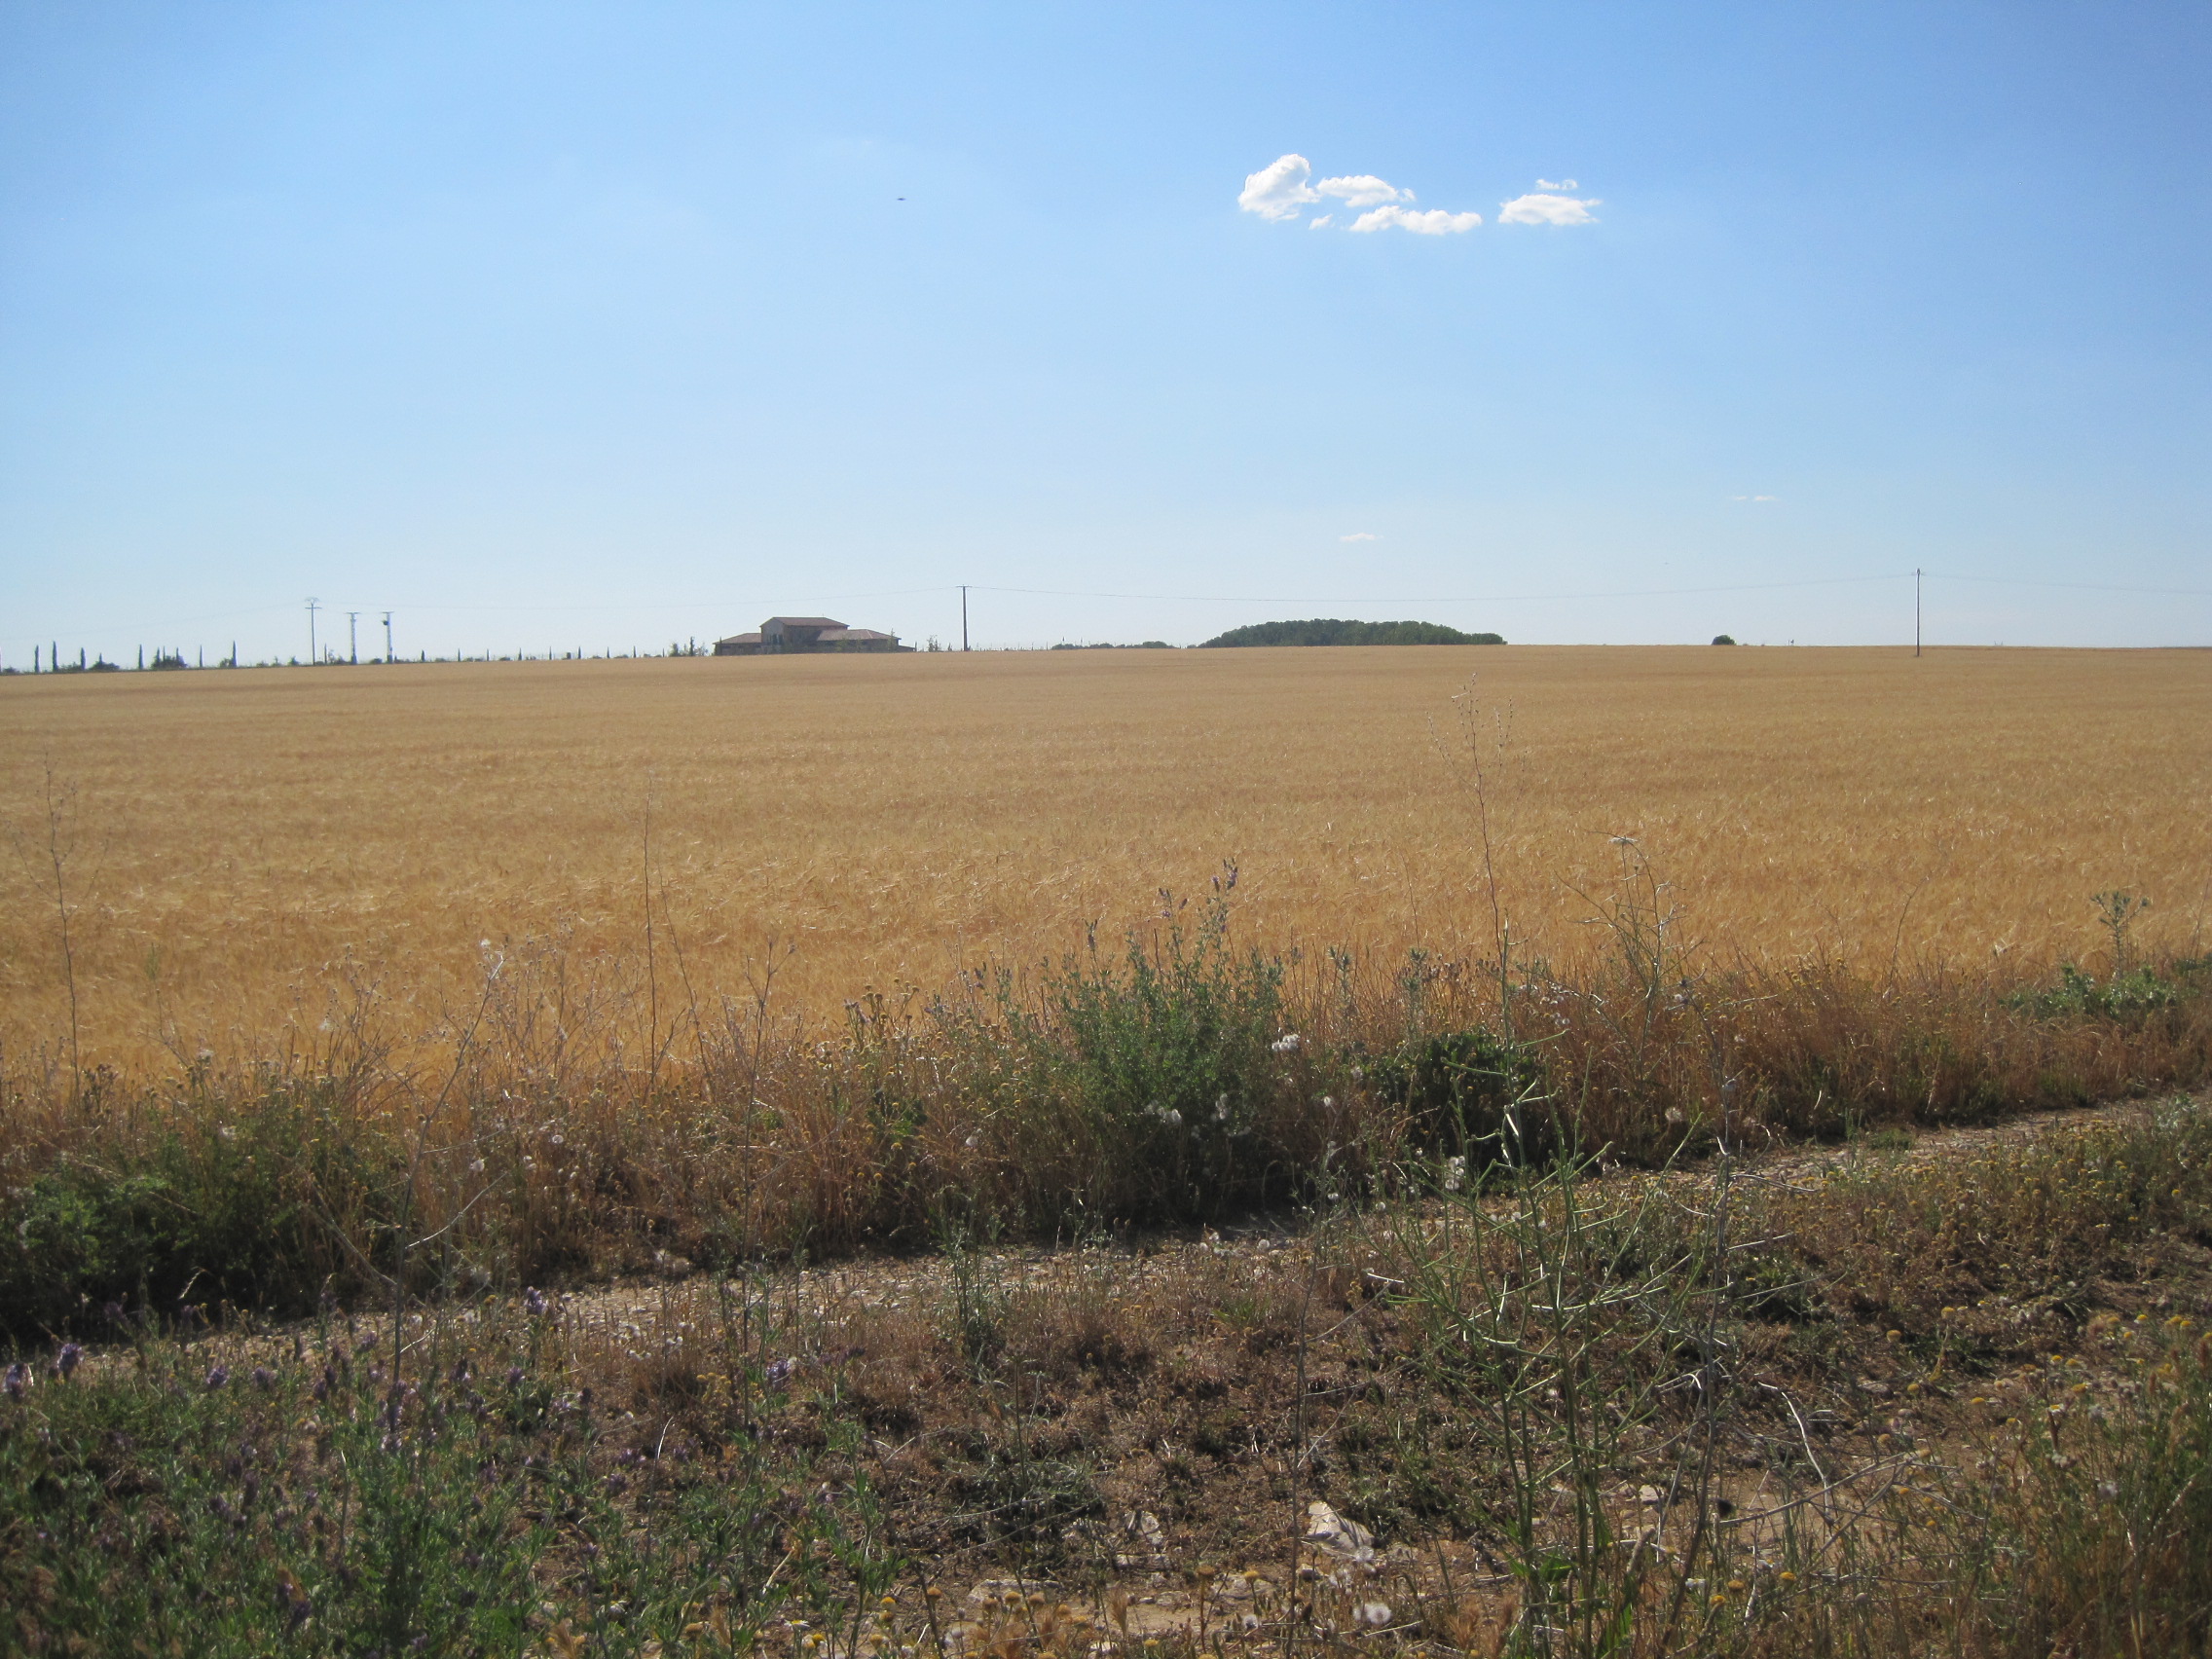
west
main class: Cropland
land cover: Common wheat
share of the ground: > 75 %
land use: Agriculture (excluding fallow land and kitchen gardens)
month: June
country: ES
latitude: 41.7528
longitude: -5.2206
